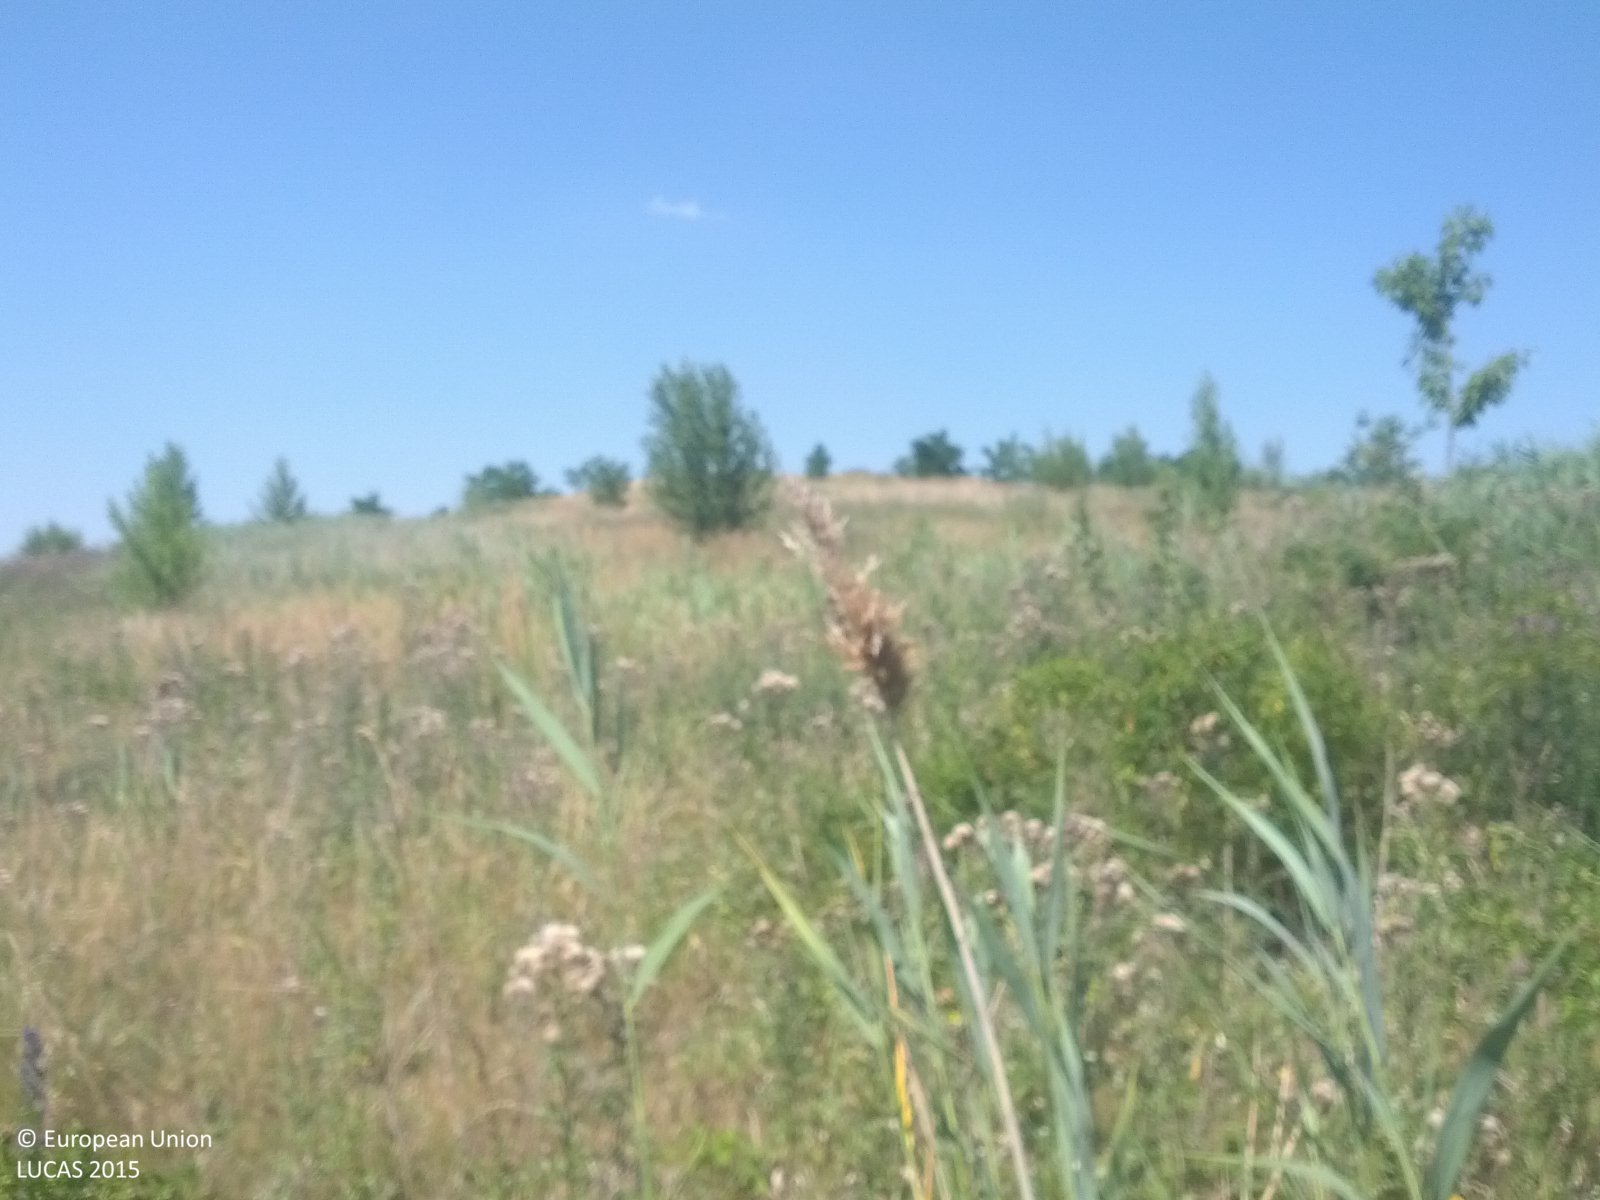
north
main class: Grassland
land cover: Grassland with sparse tree/shrub cover
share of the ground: > 75 %
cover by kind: herbaceous plants 85 %, shrubs 10 %, broadleaved forest trees 5 %
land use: Abandoned areas
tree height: < 5 m
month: July
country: AT
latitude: 48.4953
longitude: 16.5967
